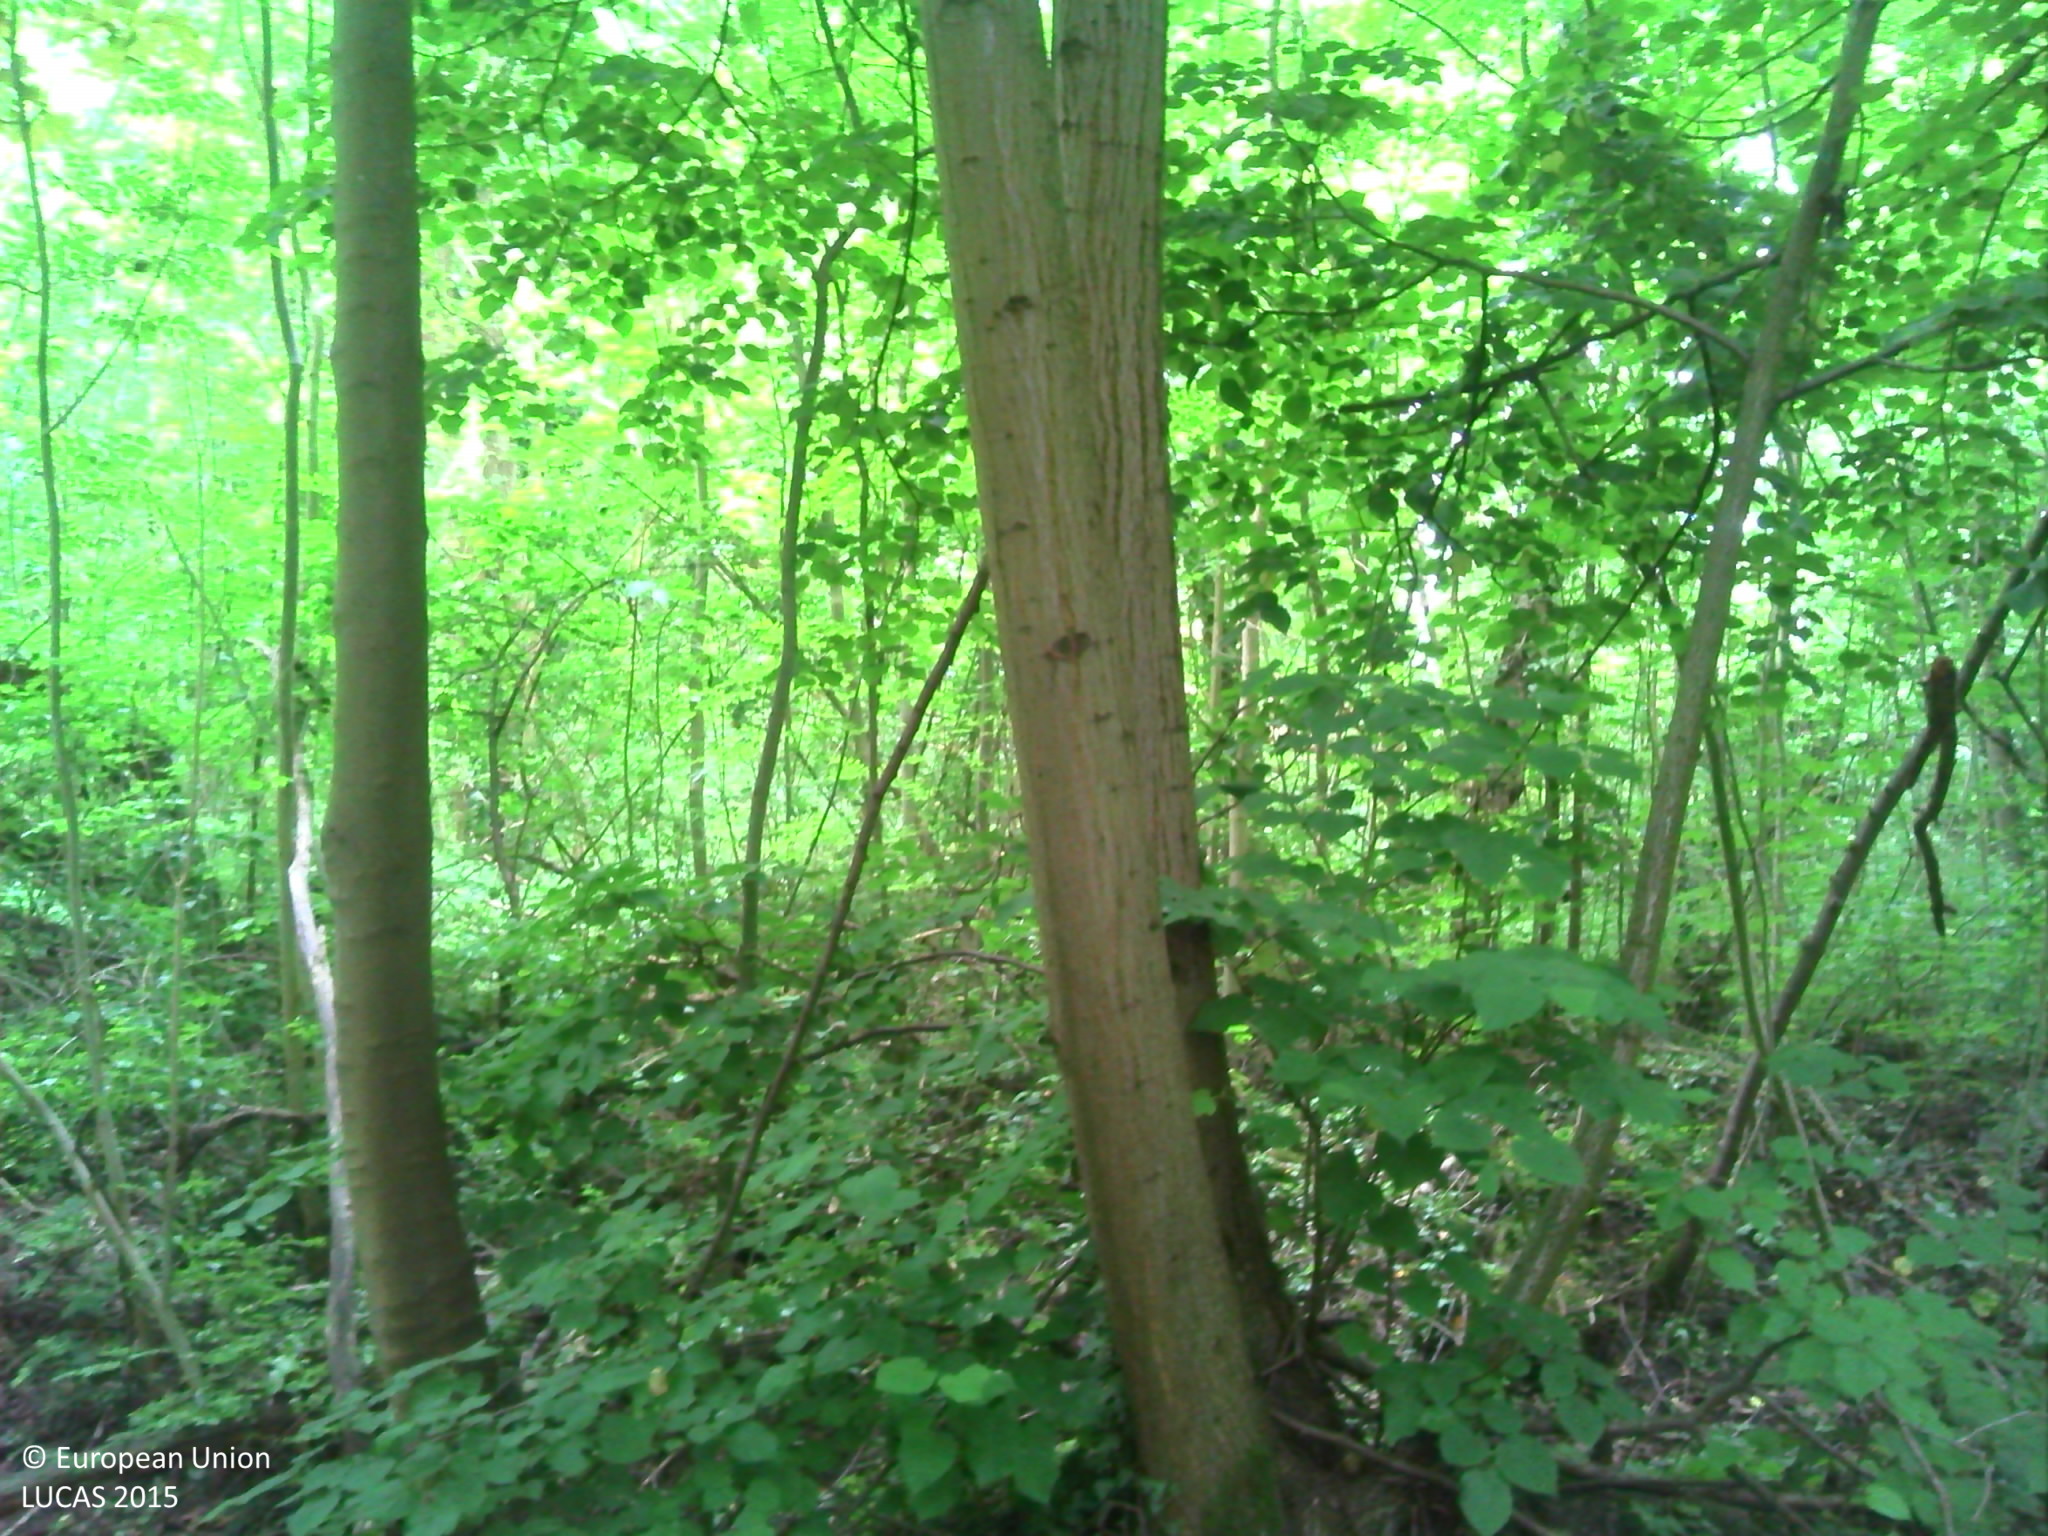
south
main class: Woodland
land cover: Broadleaved woodland
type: acidophilous oak and oak-birch forest
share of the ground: > 75 %
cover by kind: broadleaved forest trees 75 %, herbaceous plants 15 %, coniferous forest trees 10 %
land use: Forestry
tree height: > 5 m
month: June
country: BE
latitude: 50.8624
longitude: 4.4974
